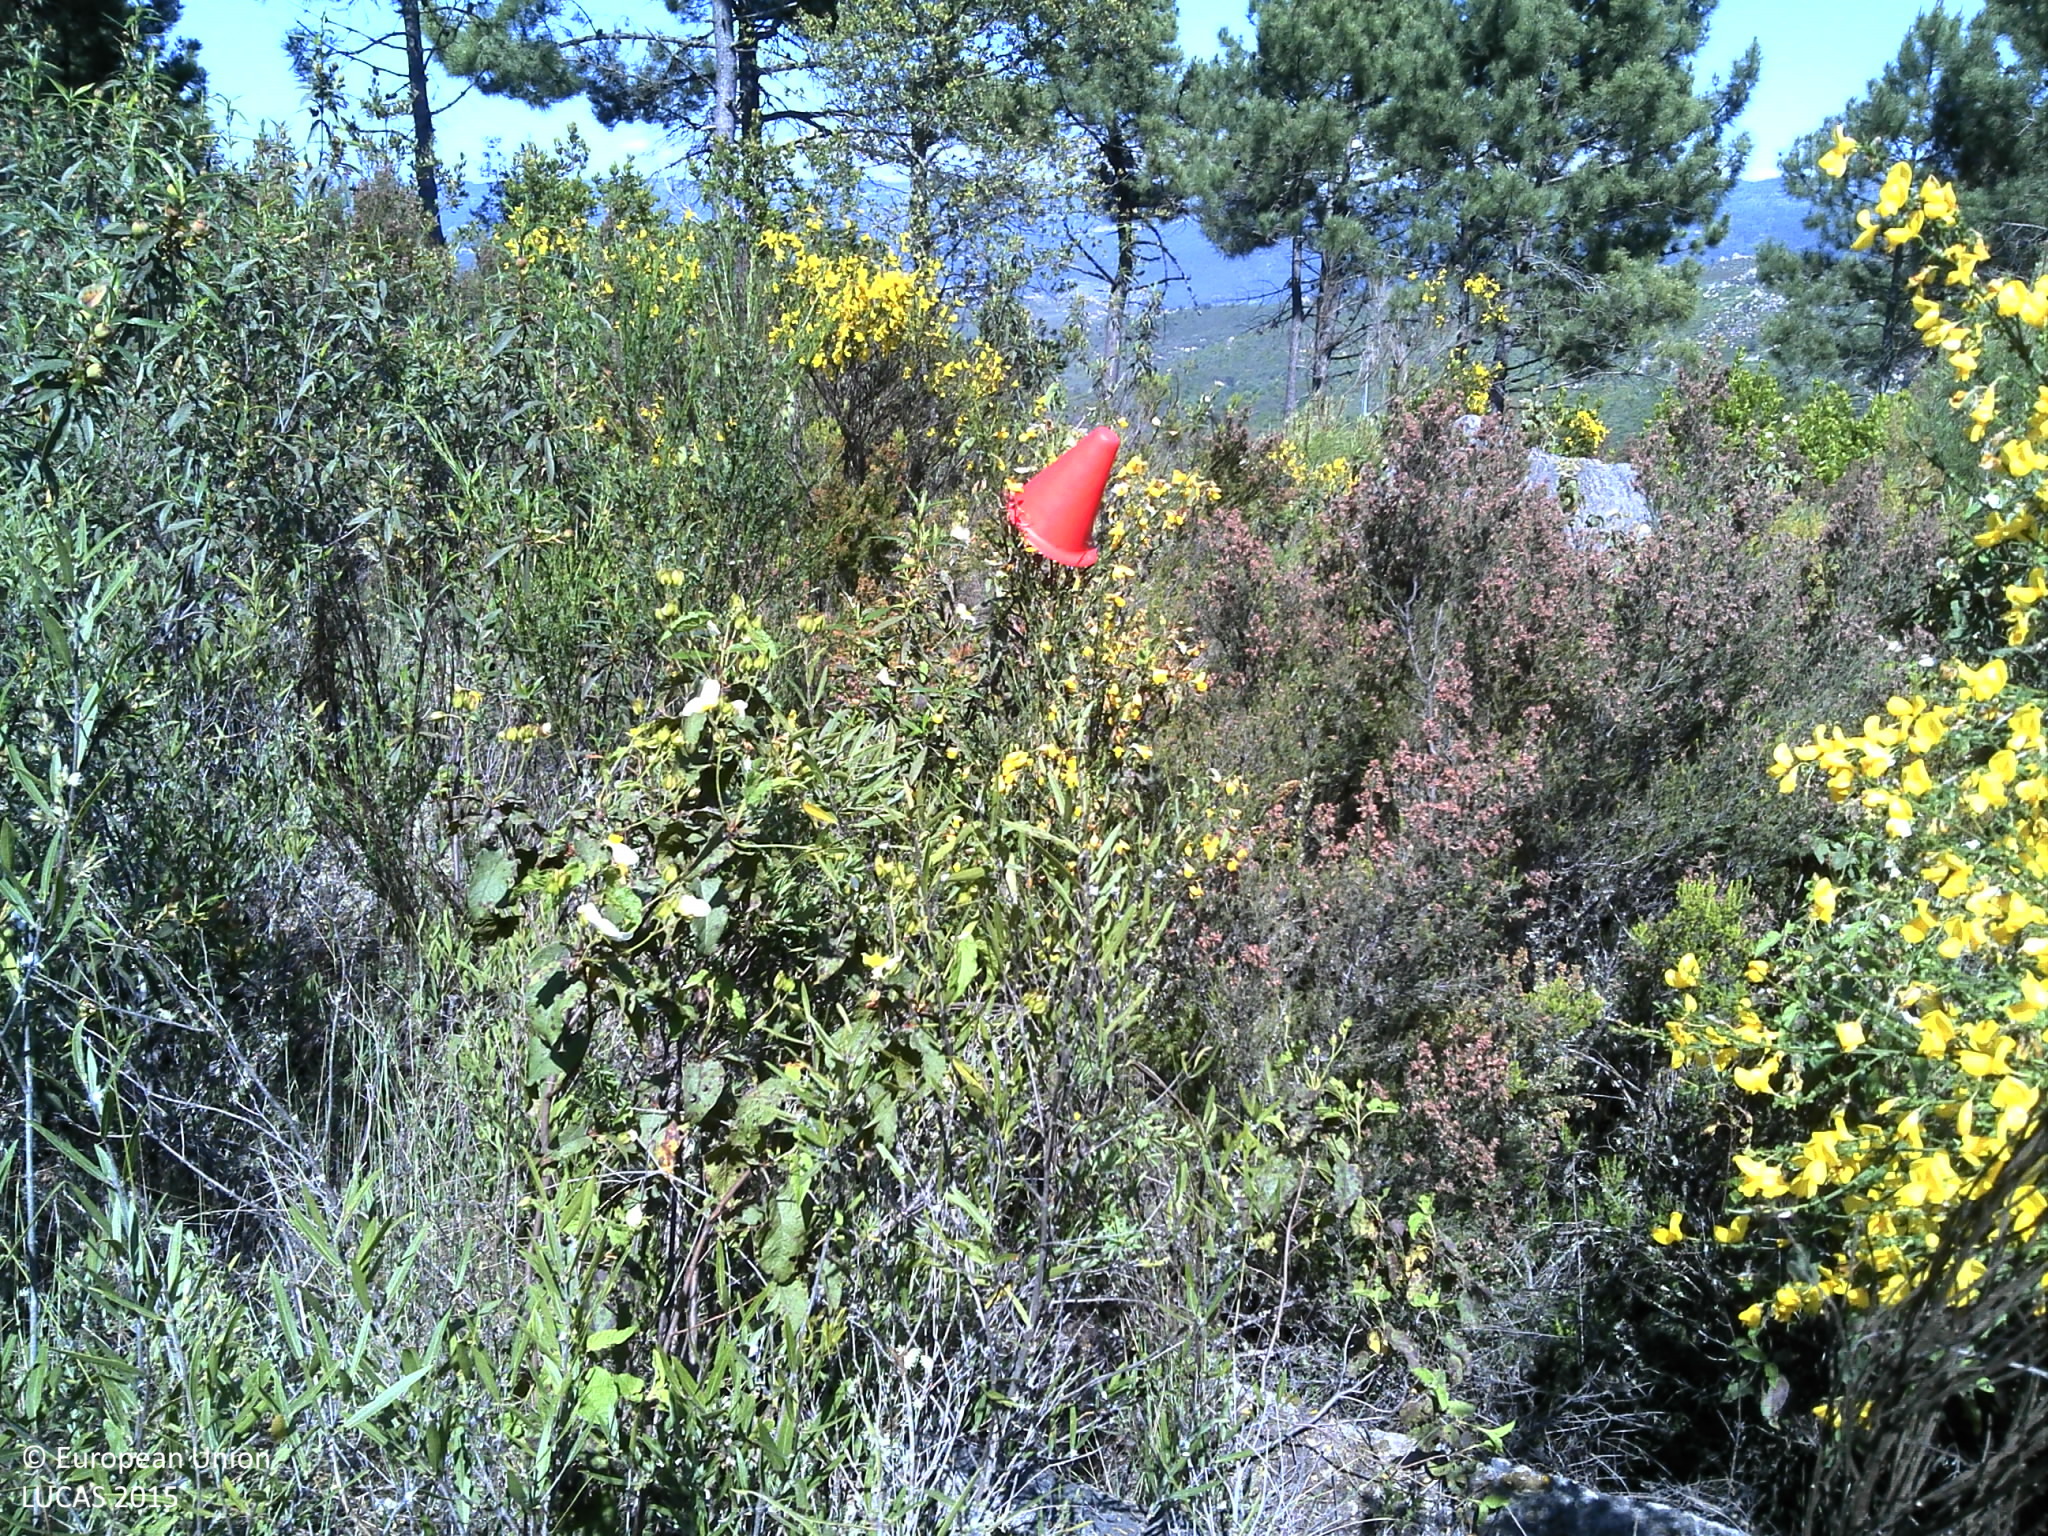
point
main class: Shrubland
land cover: Shrubland with sparse tree cover
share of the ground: > 75 %
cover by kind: shrubs 95 %, coniferous forest trees 5 %
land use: Forestry
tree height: > 5 m
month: May
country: PT
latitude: 41.5986
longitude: -7.5877
